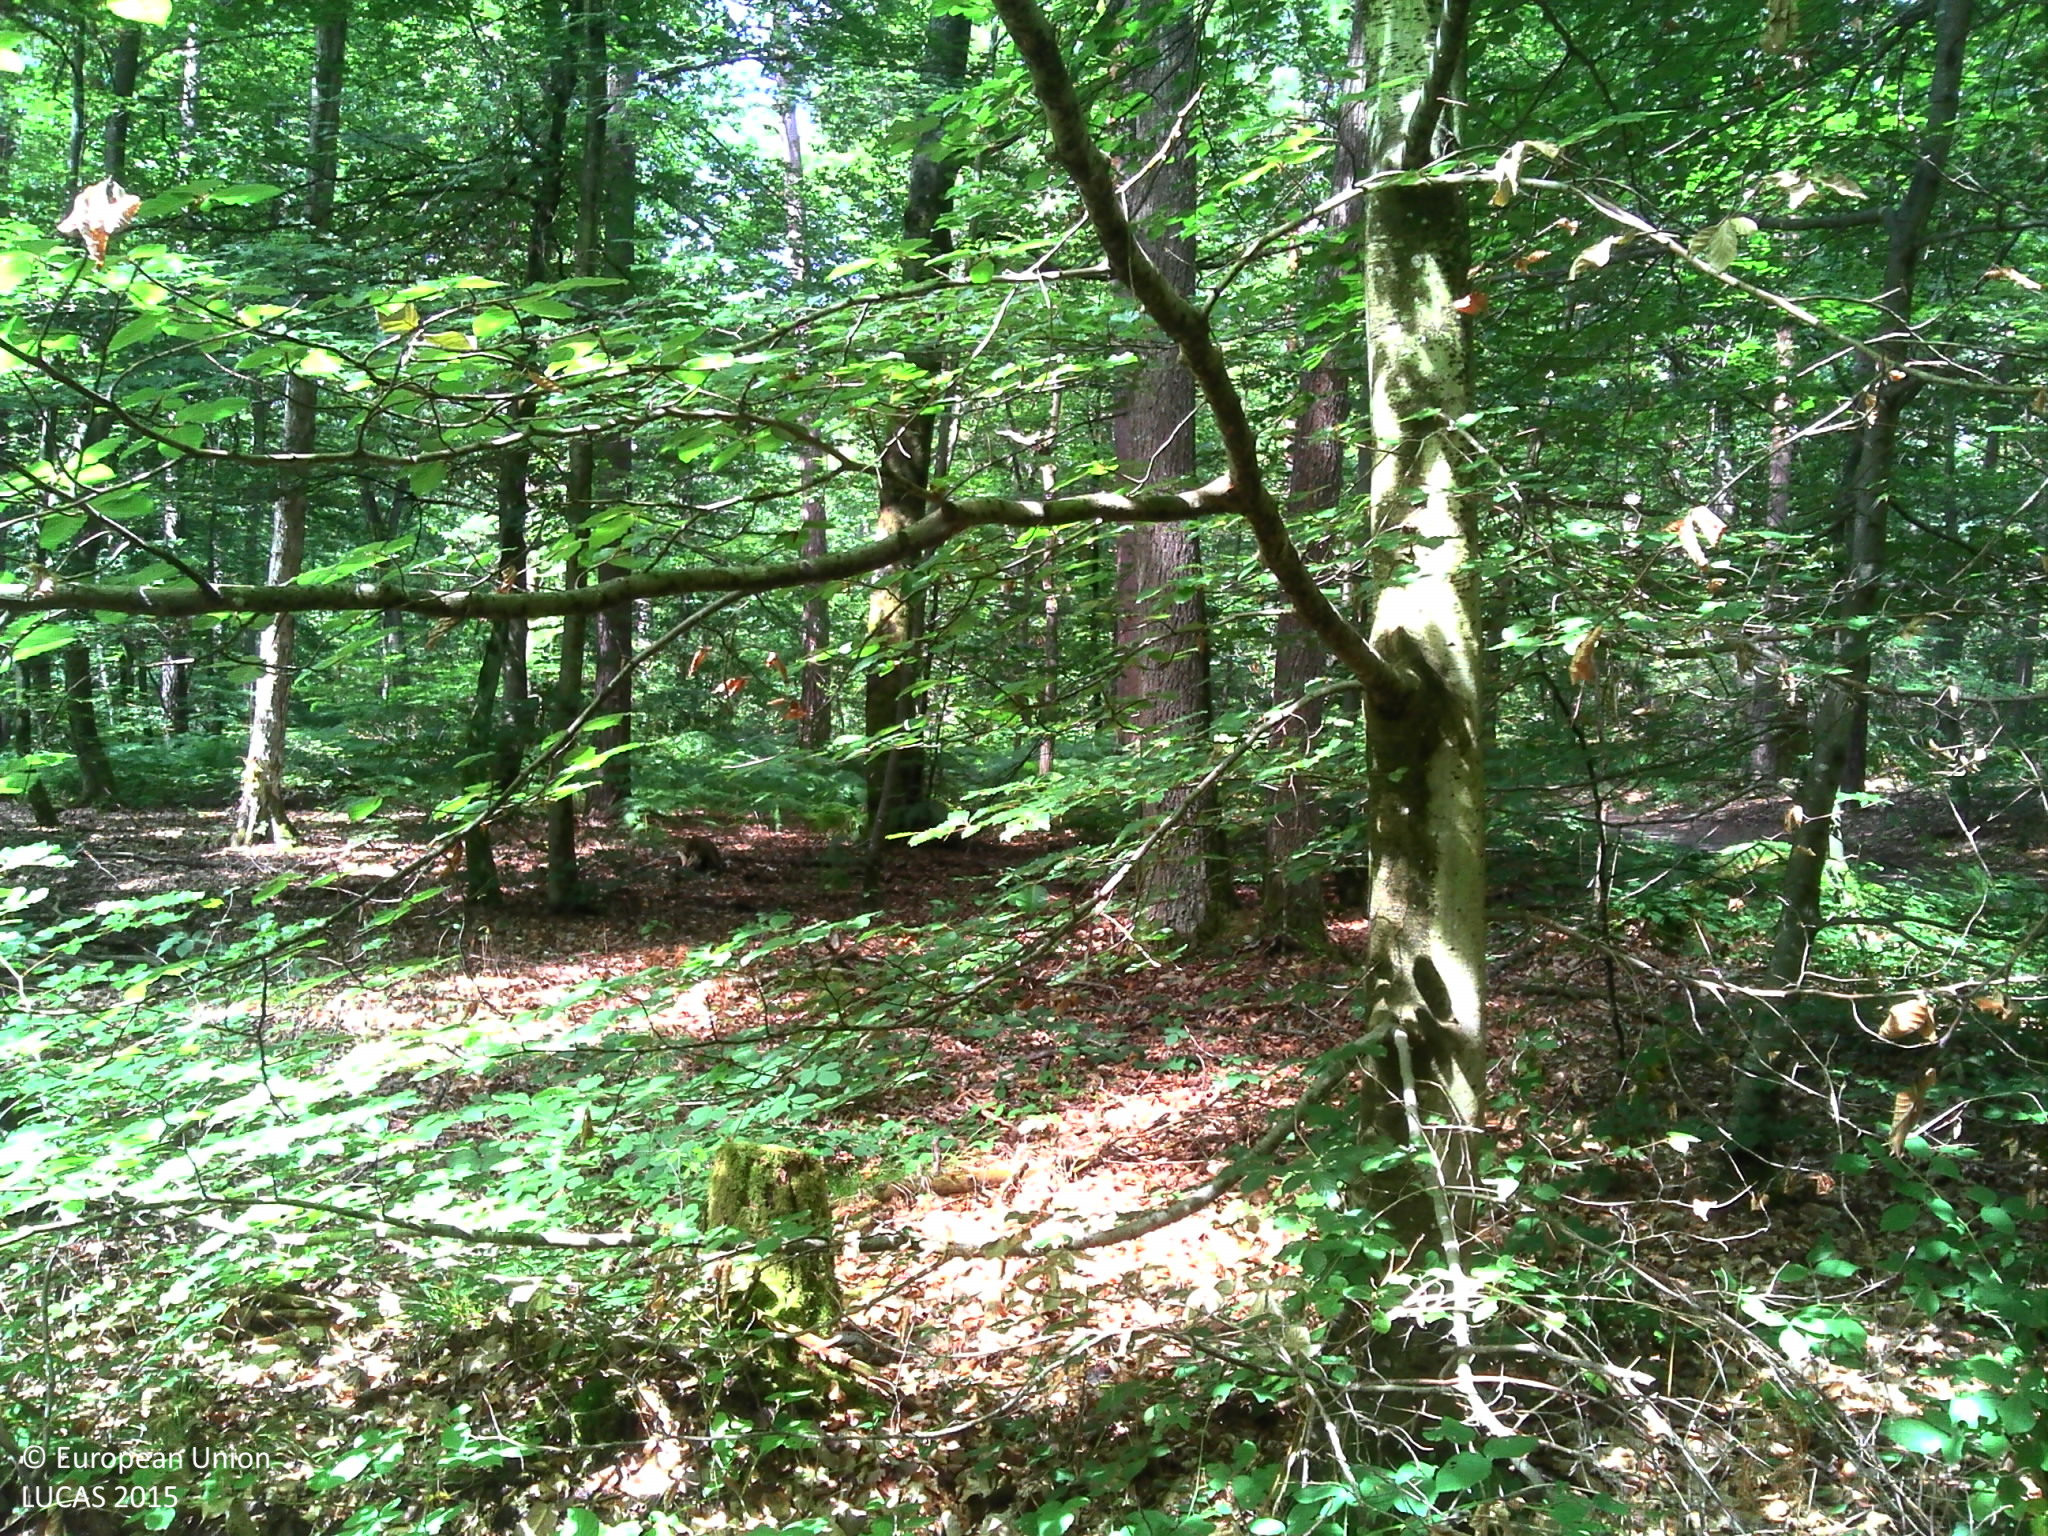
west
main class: Woodland
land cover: Broadleaved woodland
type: thermophilous deciduous forest
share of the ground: > 75 %
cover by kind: shrubs 40 %, broadleaved forest trees 30 %, unconsolidated bare surface 30 %
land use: Forestry
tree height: > 5 m
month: August
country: FR
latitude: 48.3994
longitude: 2.7375
